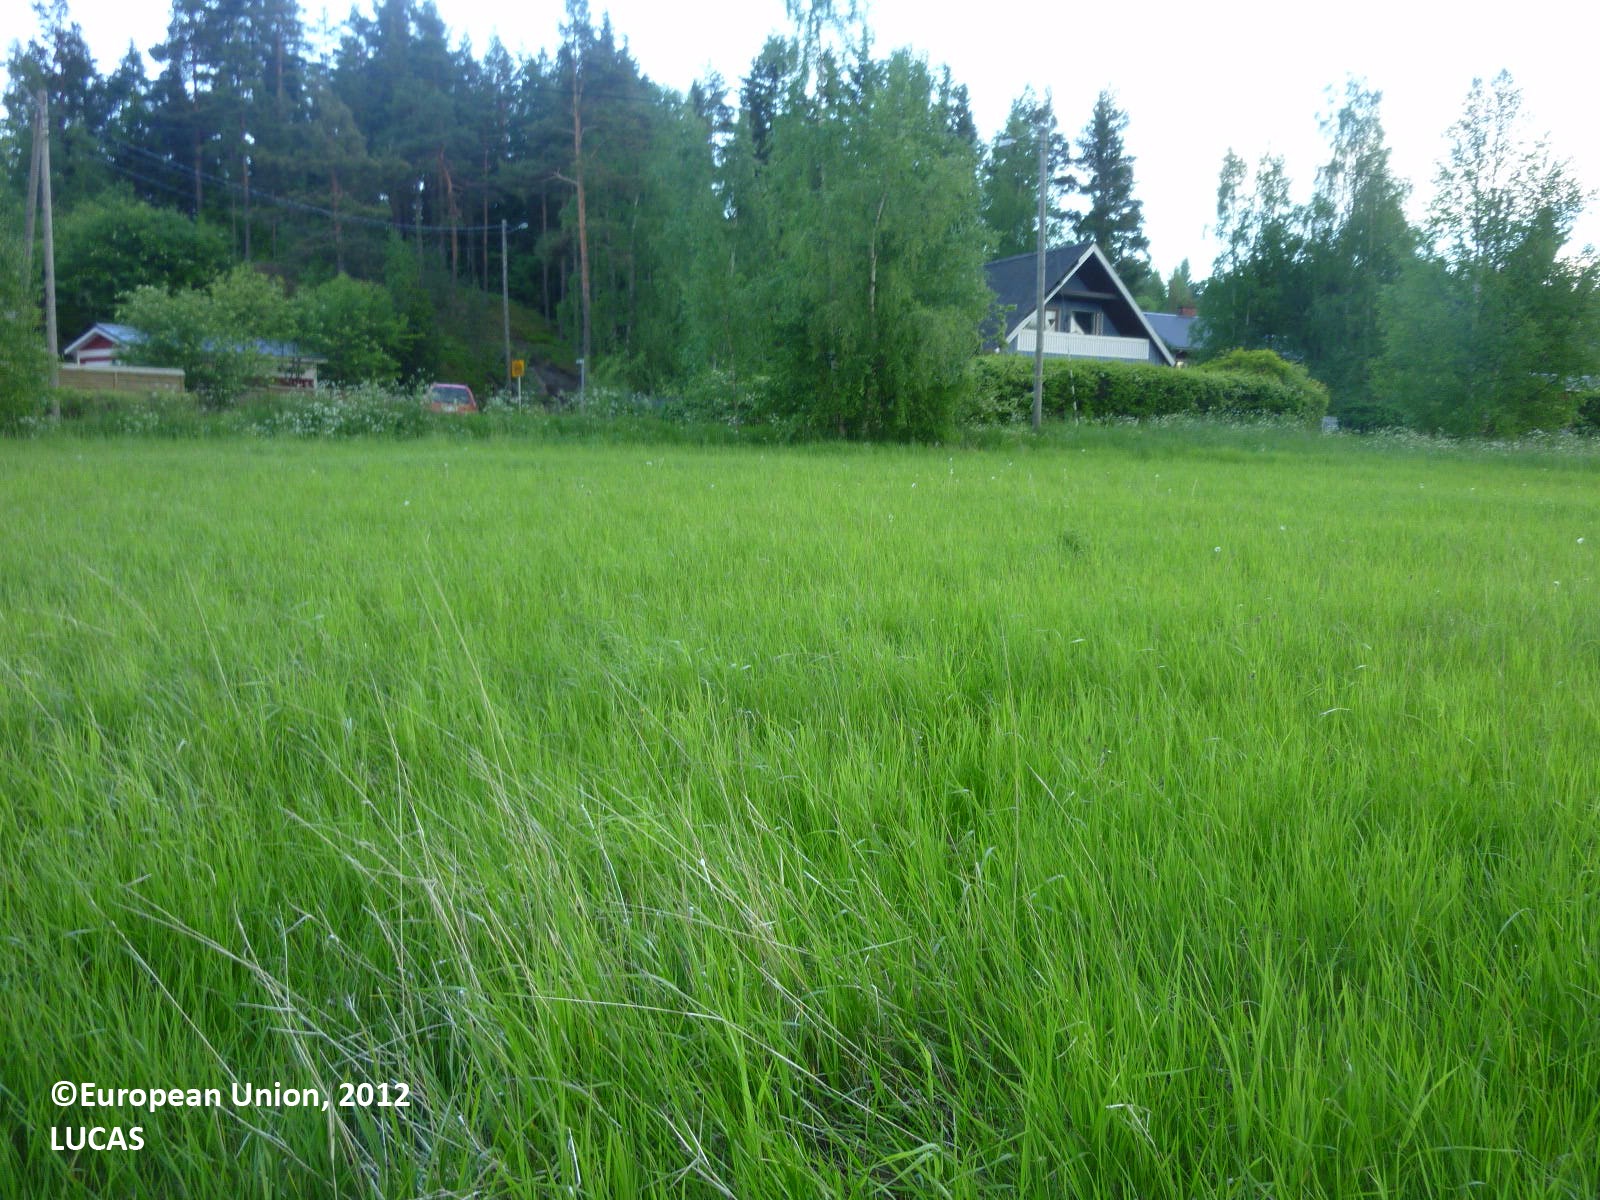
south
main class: Grassland
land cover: Grassland without tree/shrub cover
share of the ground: > 75 %
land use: Agriculture (excluding fallow land and kitchen gardens)
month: June
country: FI
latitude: 60.4900
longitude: 22.3900
